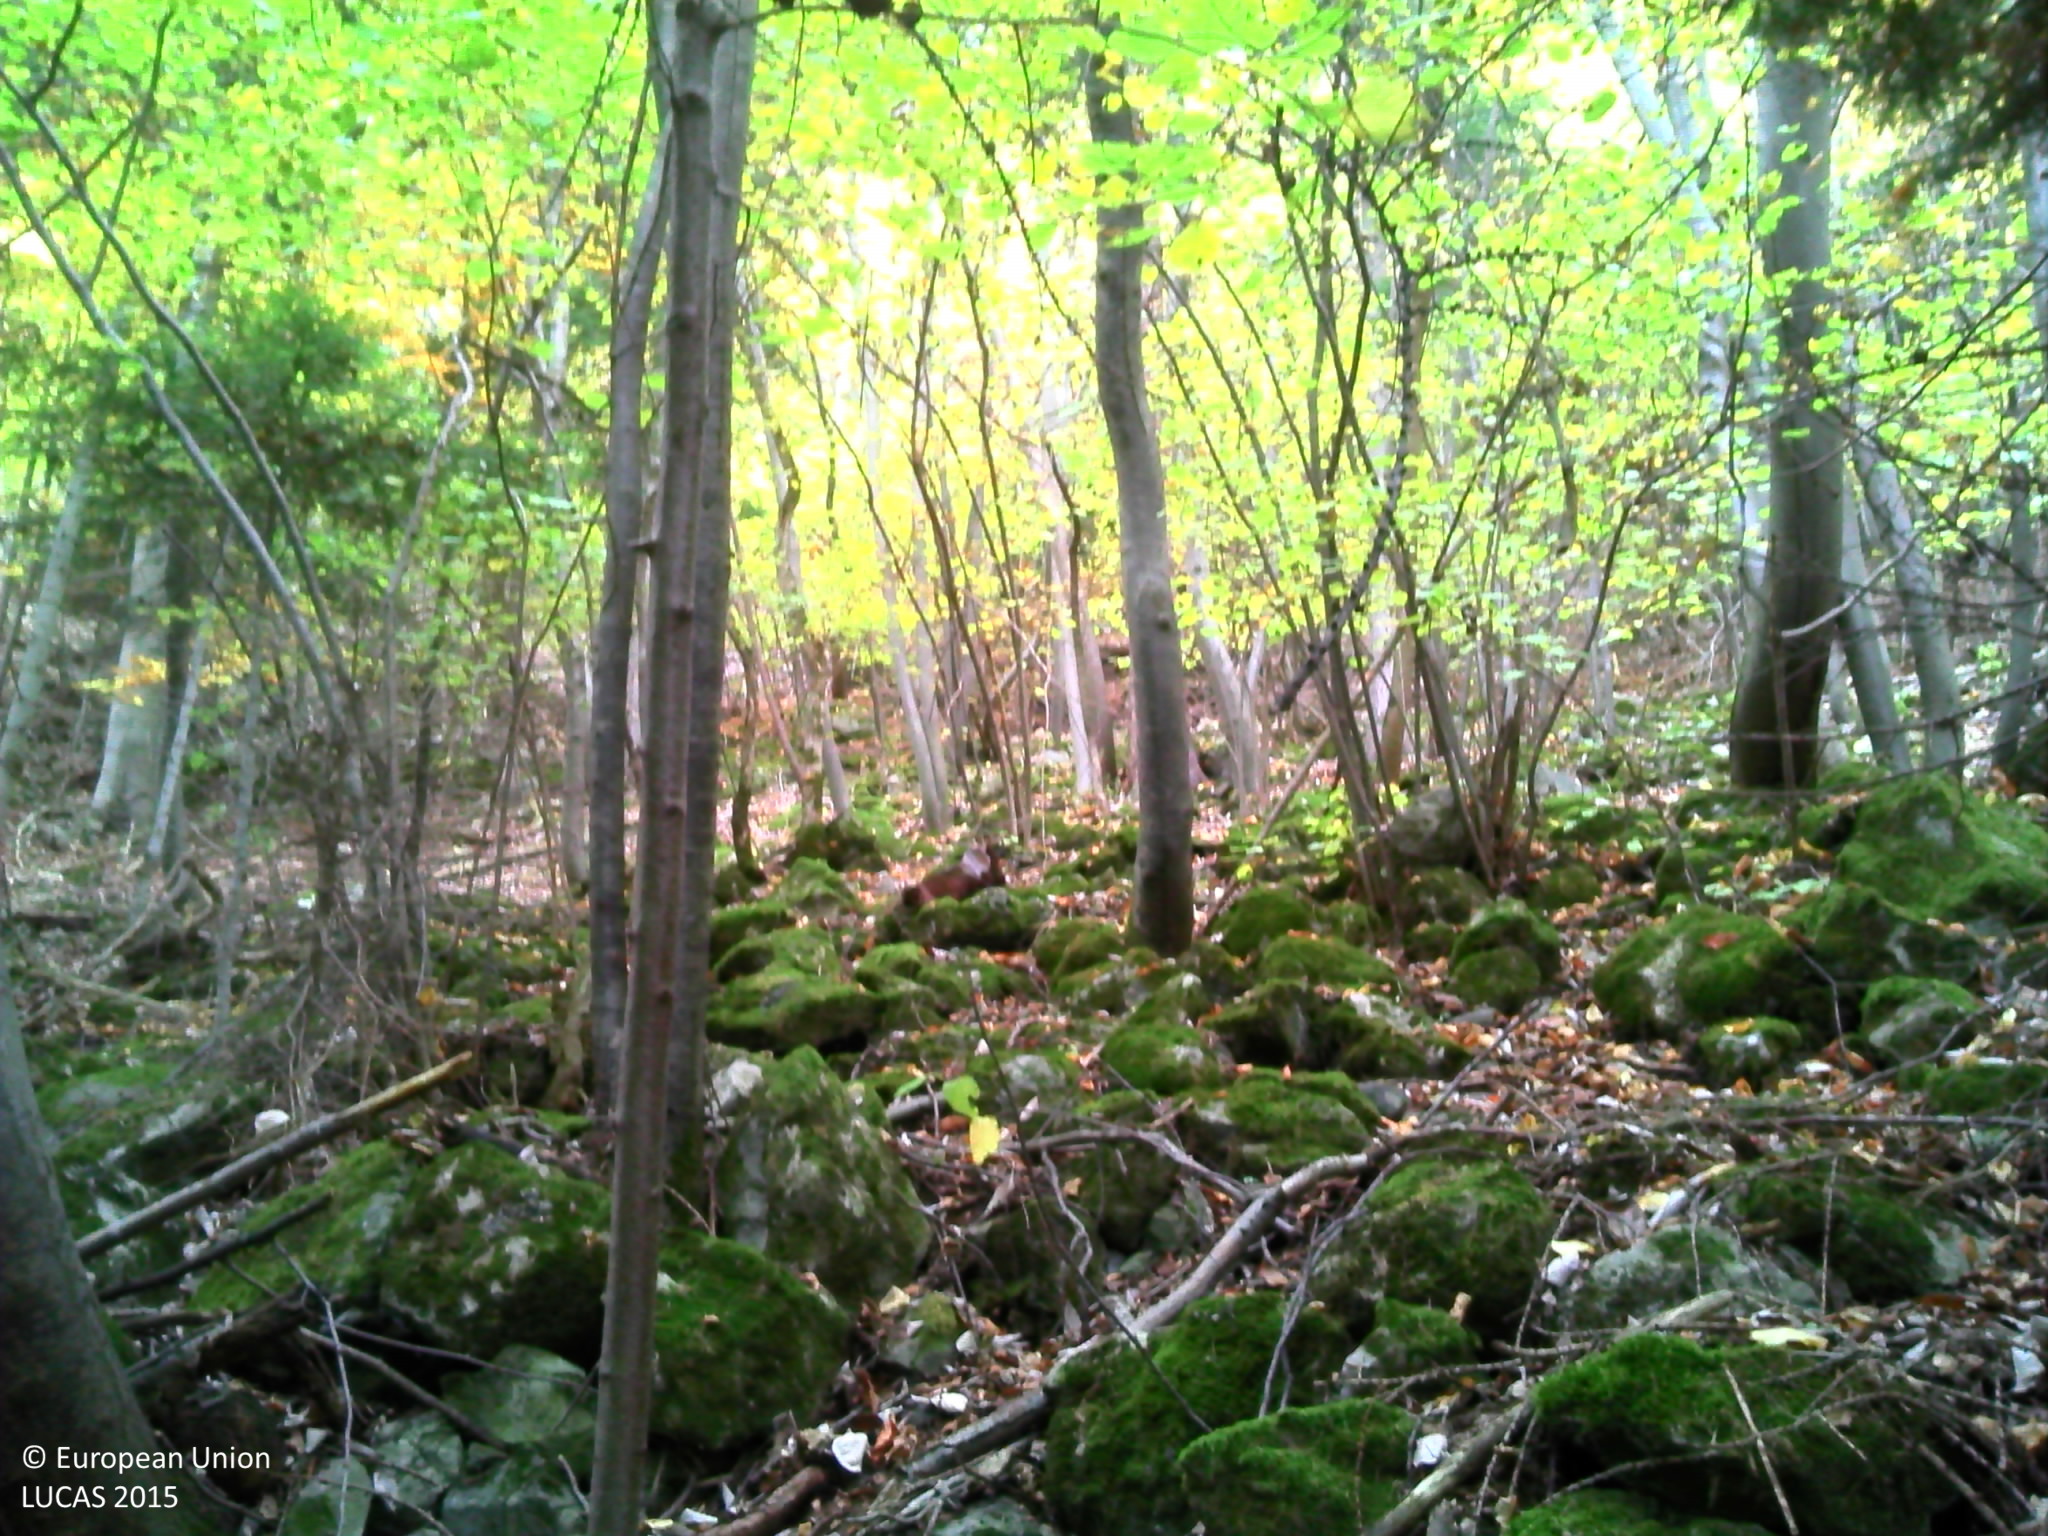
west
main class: Woodland
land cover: Spruce dominated mixed woodland
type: hemiboreal forest and nemoral coniferous forest and mixed broadleaved-coniferous forest
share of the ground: > 75 %
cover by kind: coniferous forest trees 50 %, broadleaved forest trees 40 %, unconsolidated bare surface 10 %
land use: Forestry
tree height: > 5 m
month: October
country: FR
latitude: 45.2103
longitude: 6.4527
